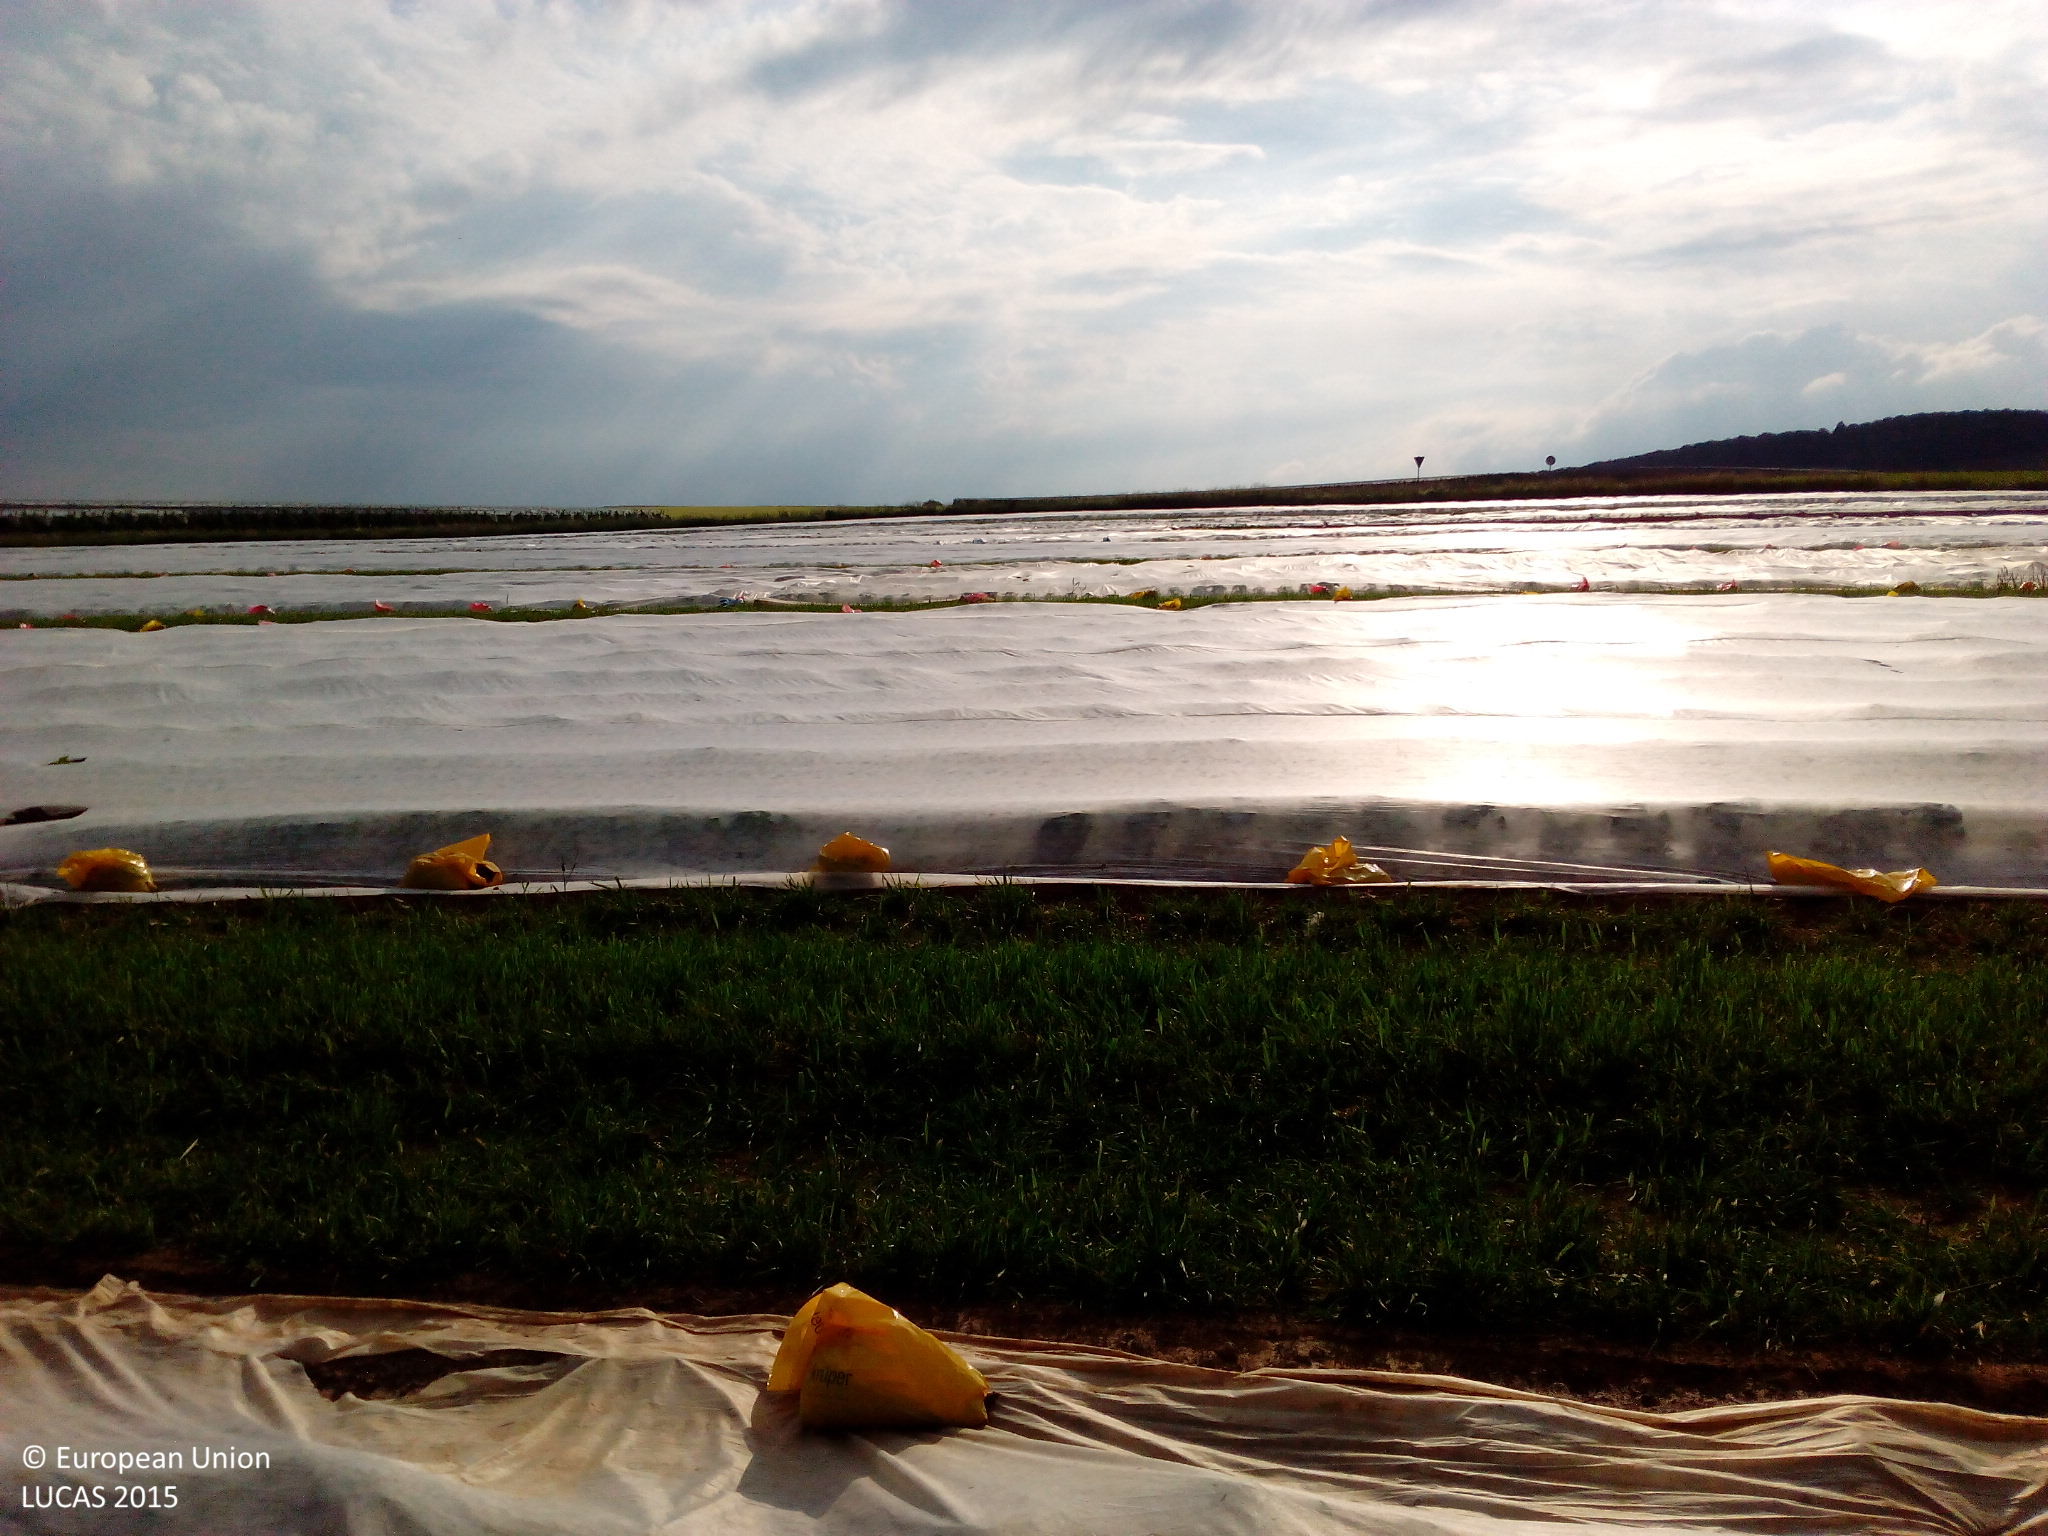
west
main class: Cropland
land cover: Other fresh vegetables
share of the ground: 10 - 25 %
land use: Agriculture (excluding fallow land and kitchen gardens)
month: May
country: DE
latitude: 49.1935
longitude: 9.4102
